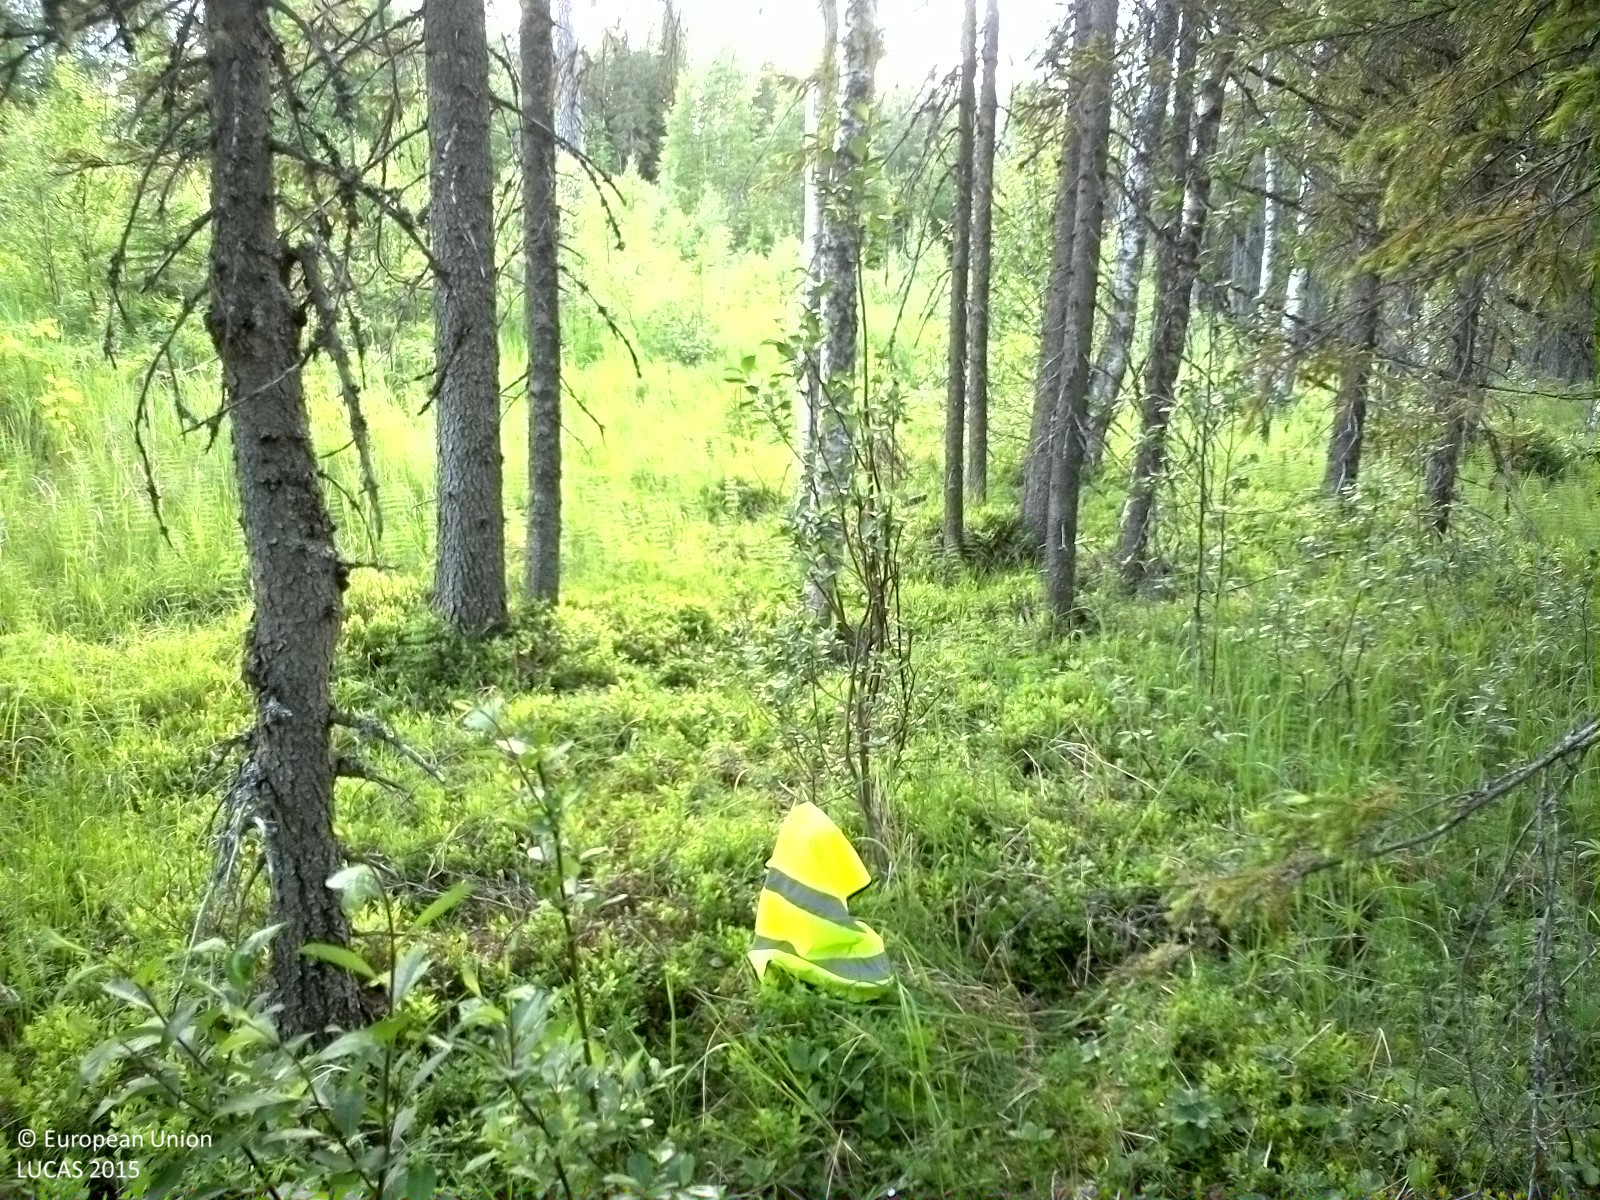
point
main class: Woodland
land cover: Spruce dominated mixed woodland
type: boreal forest
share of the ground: 50 - 75 %
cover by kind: coniferous forest trees 40 %, shrubs 40 %, broadleaved forest trees 20 %
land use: Forestry
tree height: > 5 m
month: July
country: SE
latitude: 62.2051
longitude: 16.8051
